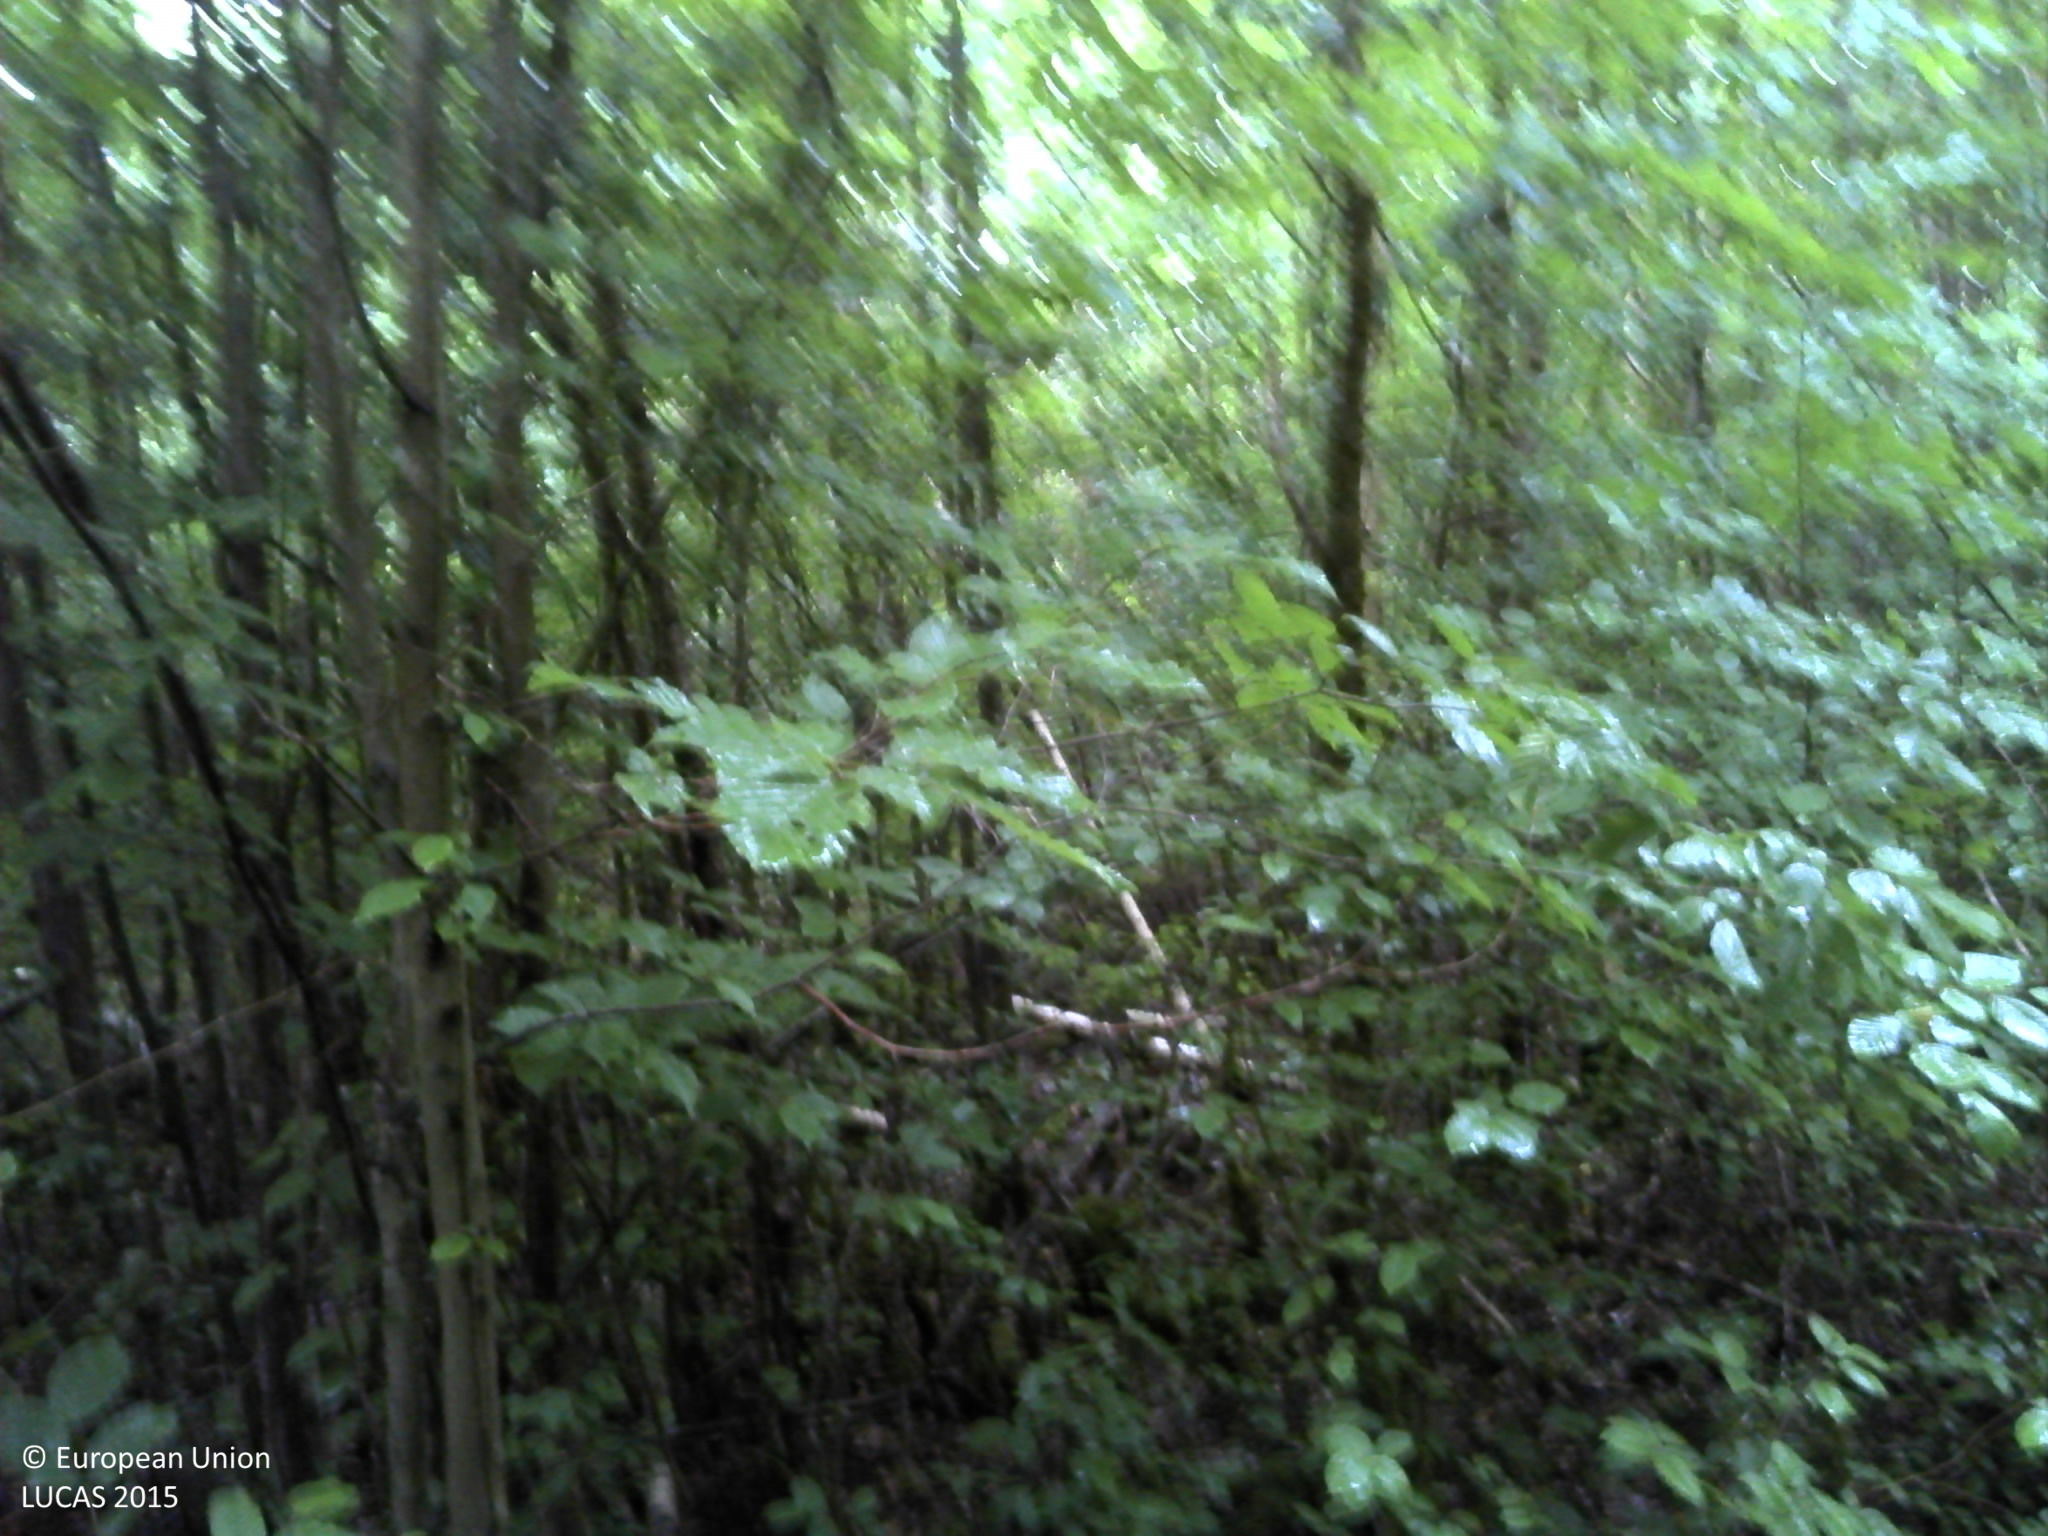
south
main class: Woodland
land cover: Broadleaved woodland
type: beech forest
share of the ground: > 75 %
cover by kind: broadleaved forest trees 85 %, herbaceous plants 5 %, lichens and mosses 5 %, consolidated bare surface 5 %
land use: Forestry
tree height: > 5 m
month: June
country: FR
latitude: 49.5345
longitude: 5.0093
